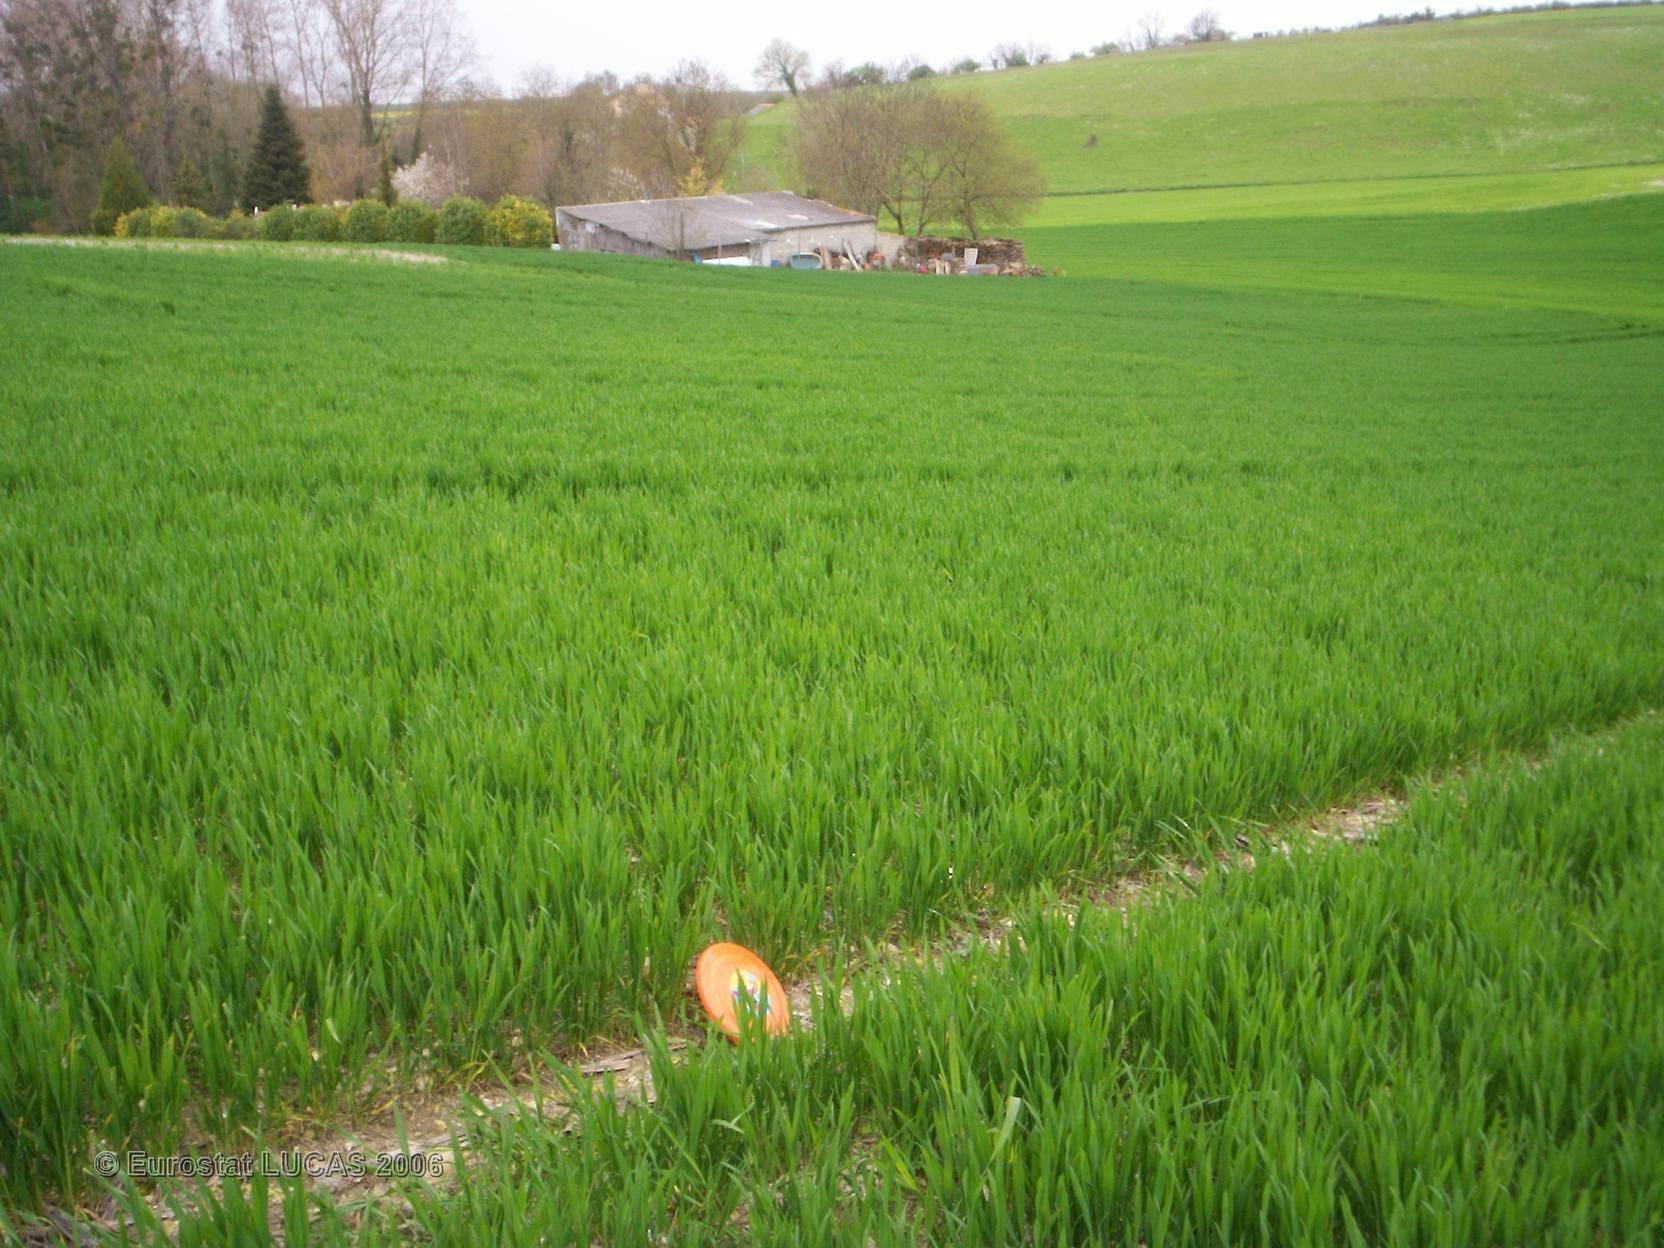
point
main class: Cropland
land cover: Durum wheat
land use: Agriculture (excluding fallow land and kitchen gardens)
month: April
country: FR
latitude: 45.4114
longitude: -0.7181
